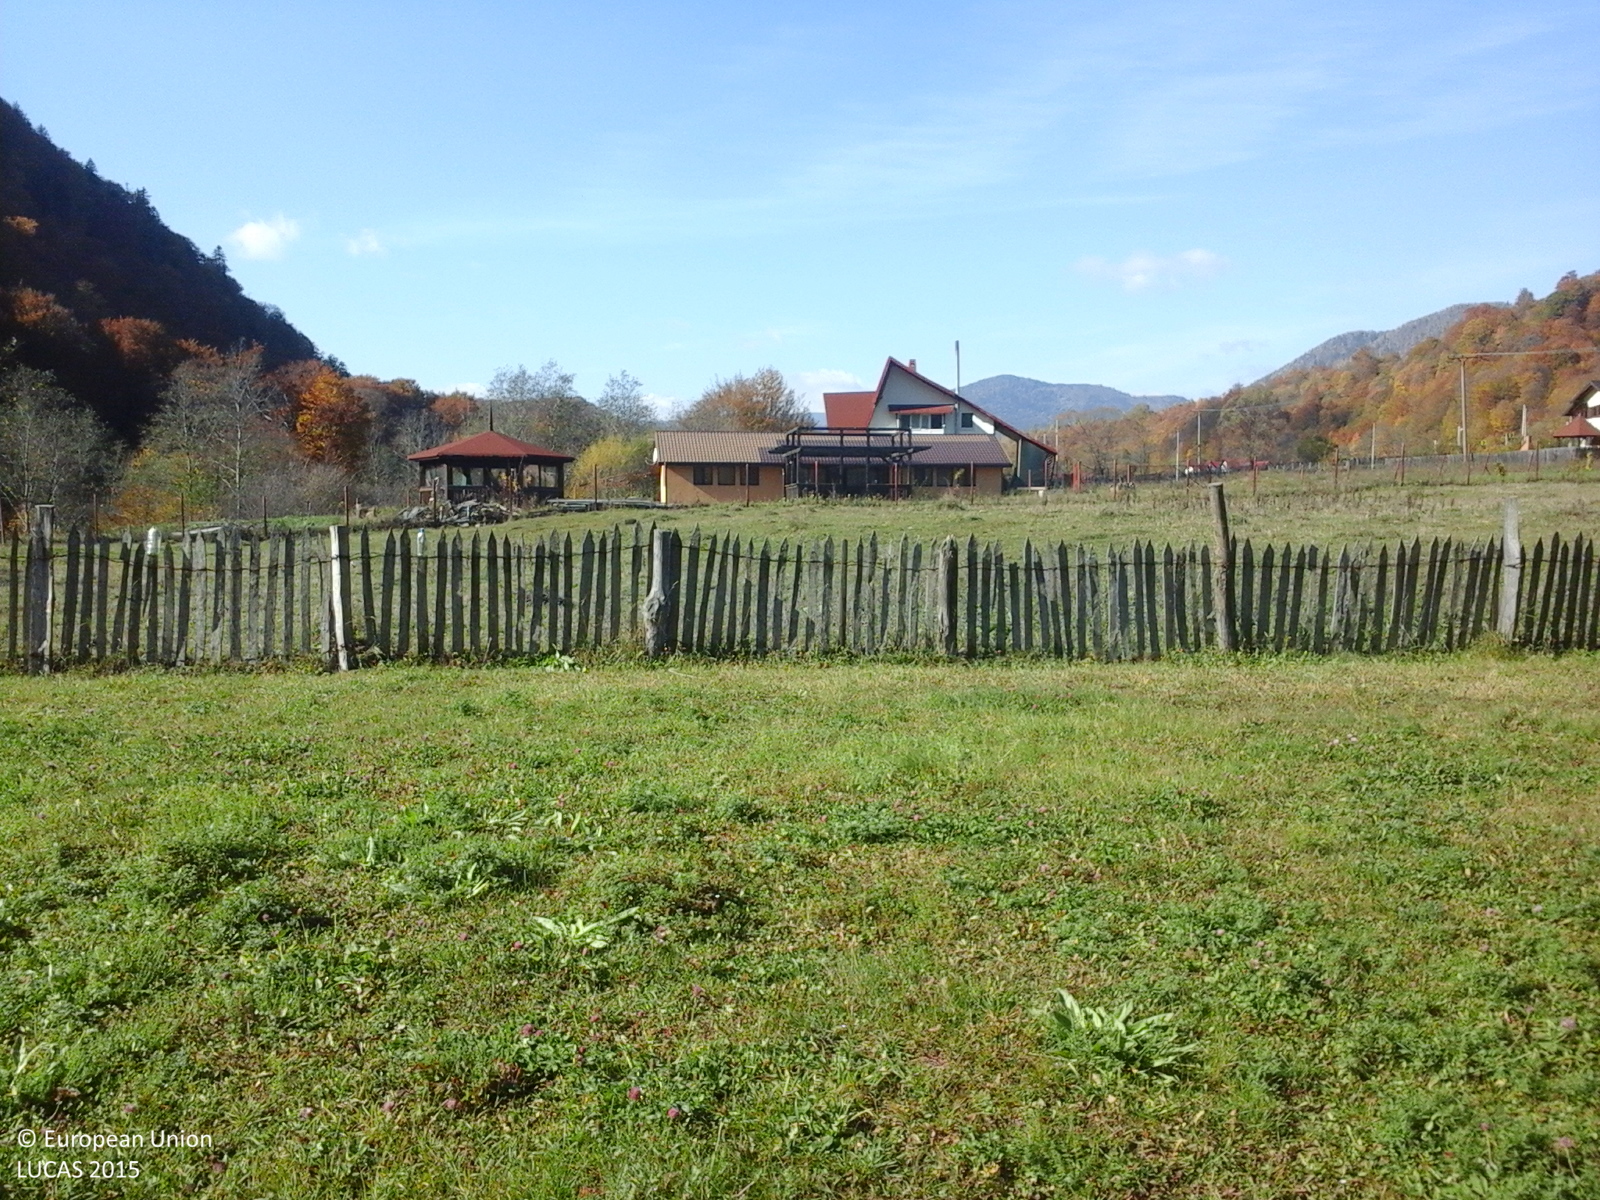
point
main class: Grassland
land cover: Grassland without tree/shrub cover
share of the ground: > 75 %
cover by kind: herbaceous plants 100 %
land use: Agriculture (excluding fallow land and kitchen gardens)
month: October
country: RO
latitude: 45.9501
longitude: 26.5537
